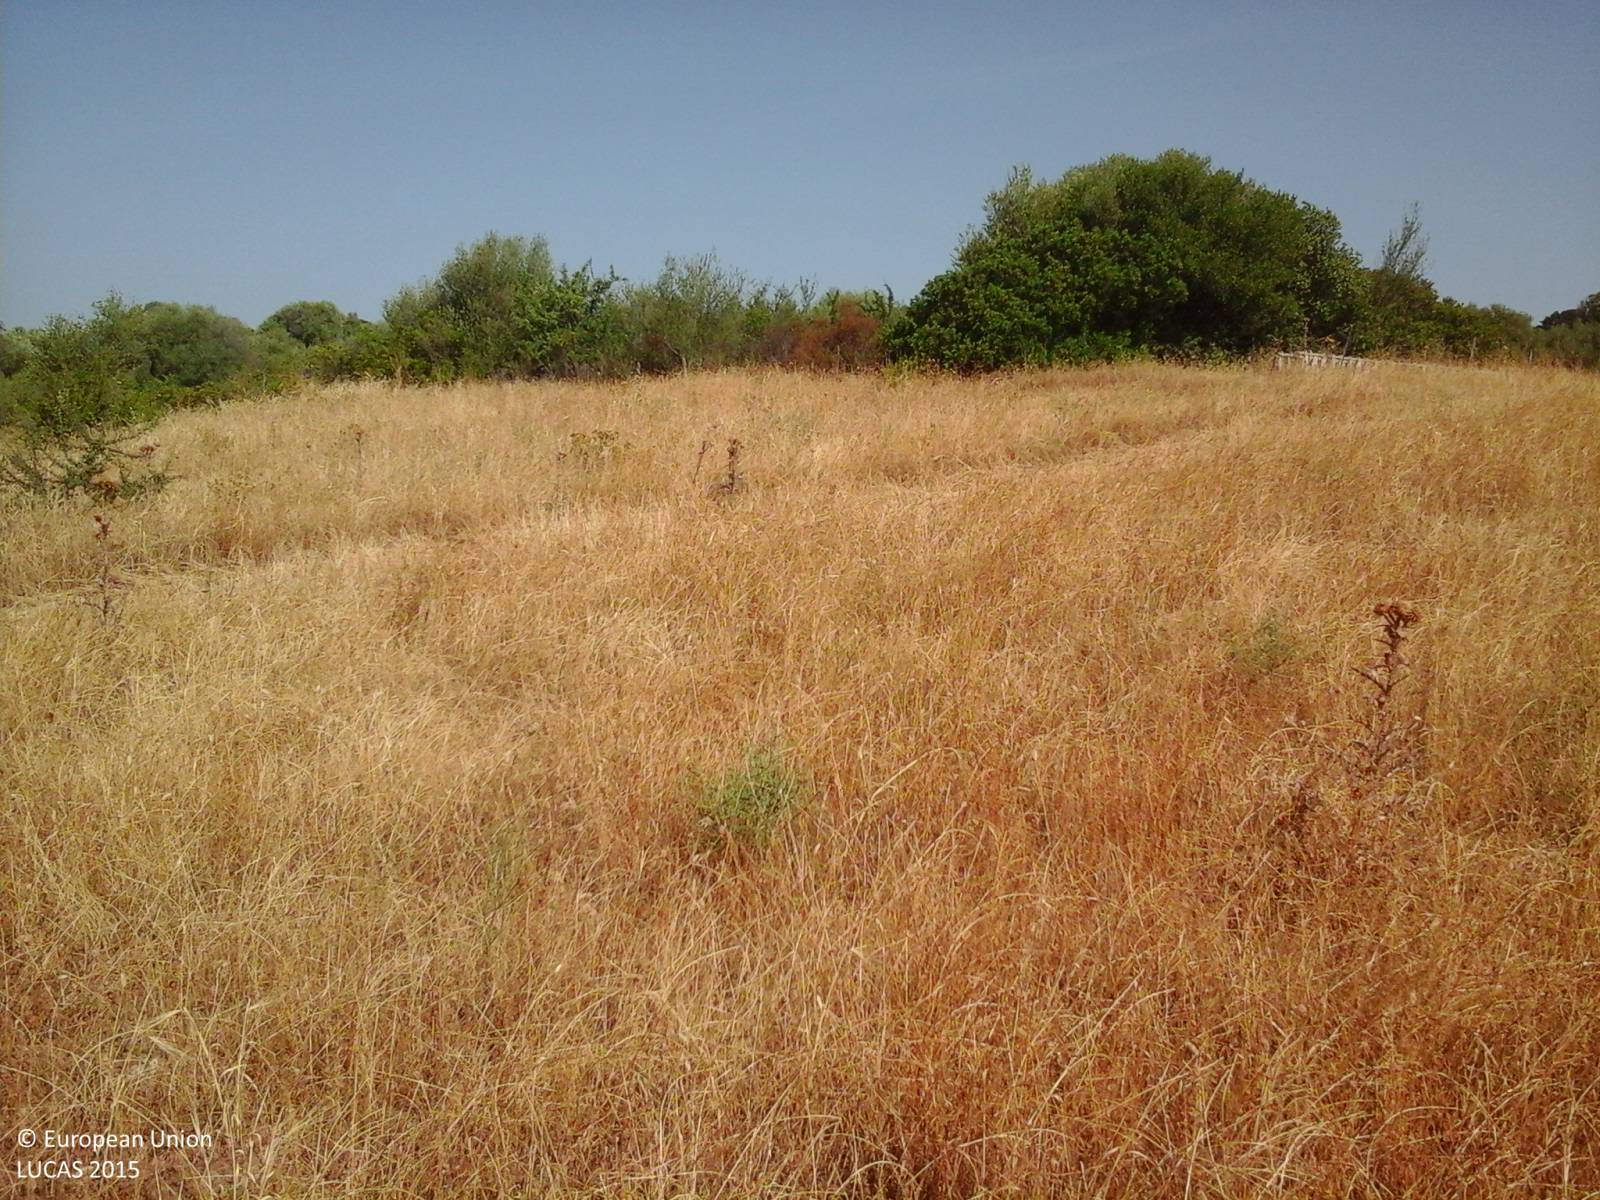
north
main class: Woodland
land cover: Broadleaved woodland
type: broadleaved evergreen forest
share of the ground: > 75 %
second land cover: Temporary grasslands
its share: > 75 %
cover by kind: broadleaved forest trees 95 %, herbaceous plants 5 %
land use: Forestry
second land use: Agriculture (excluding fallow land and kitchen gardens)
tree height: > 5 m
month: July
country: IT
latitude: 40.6283
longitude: 9.5647
